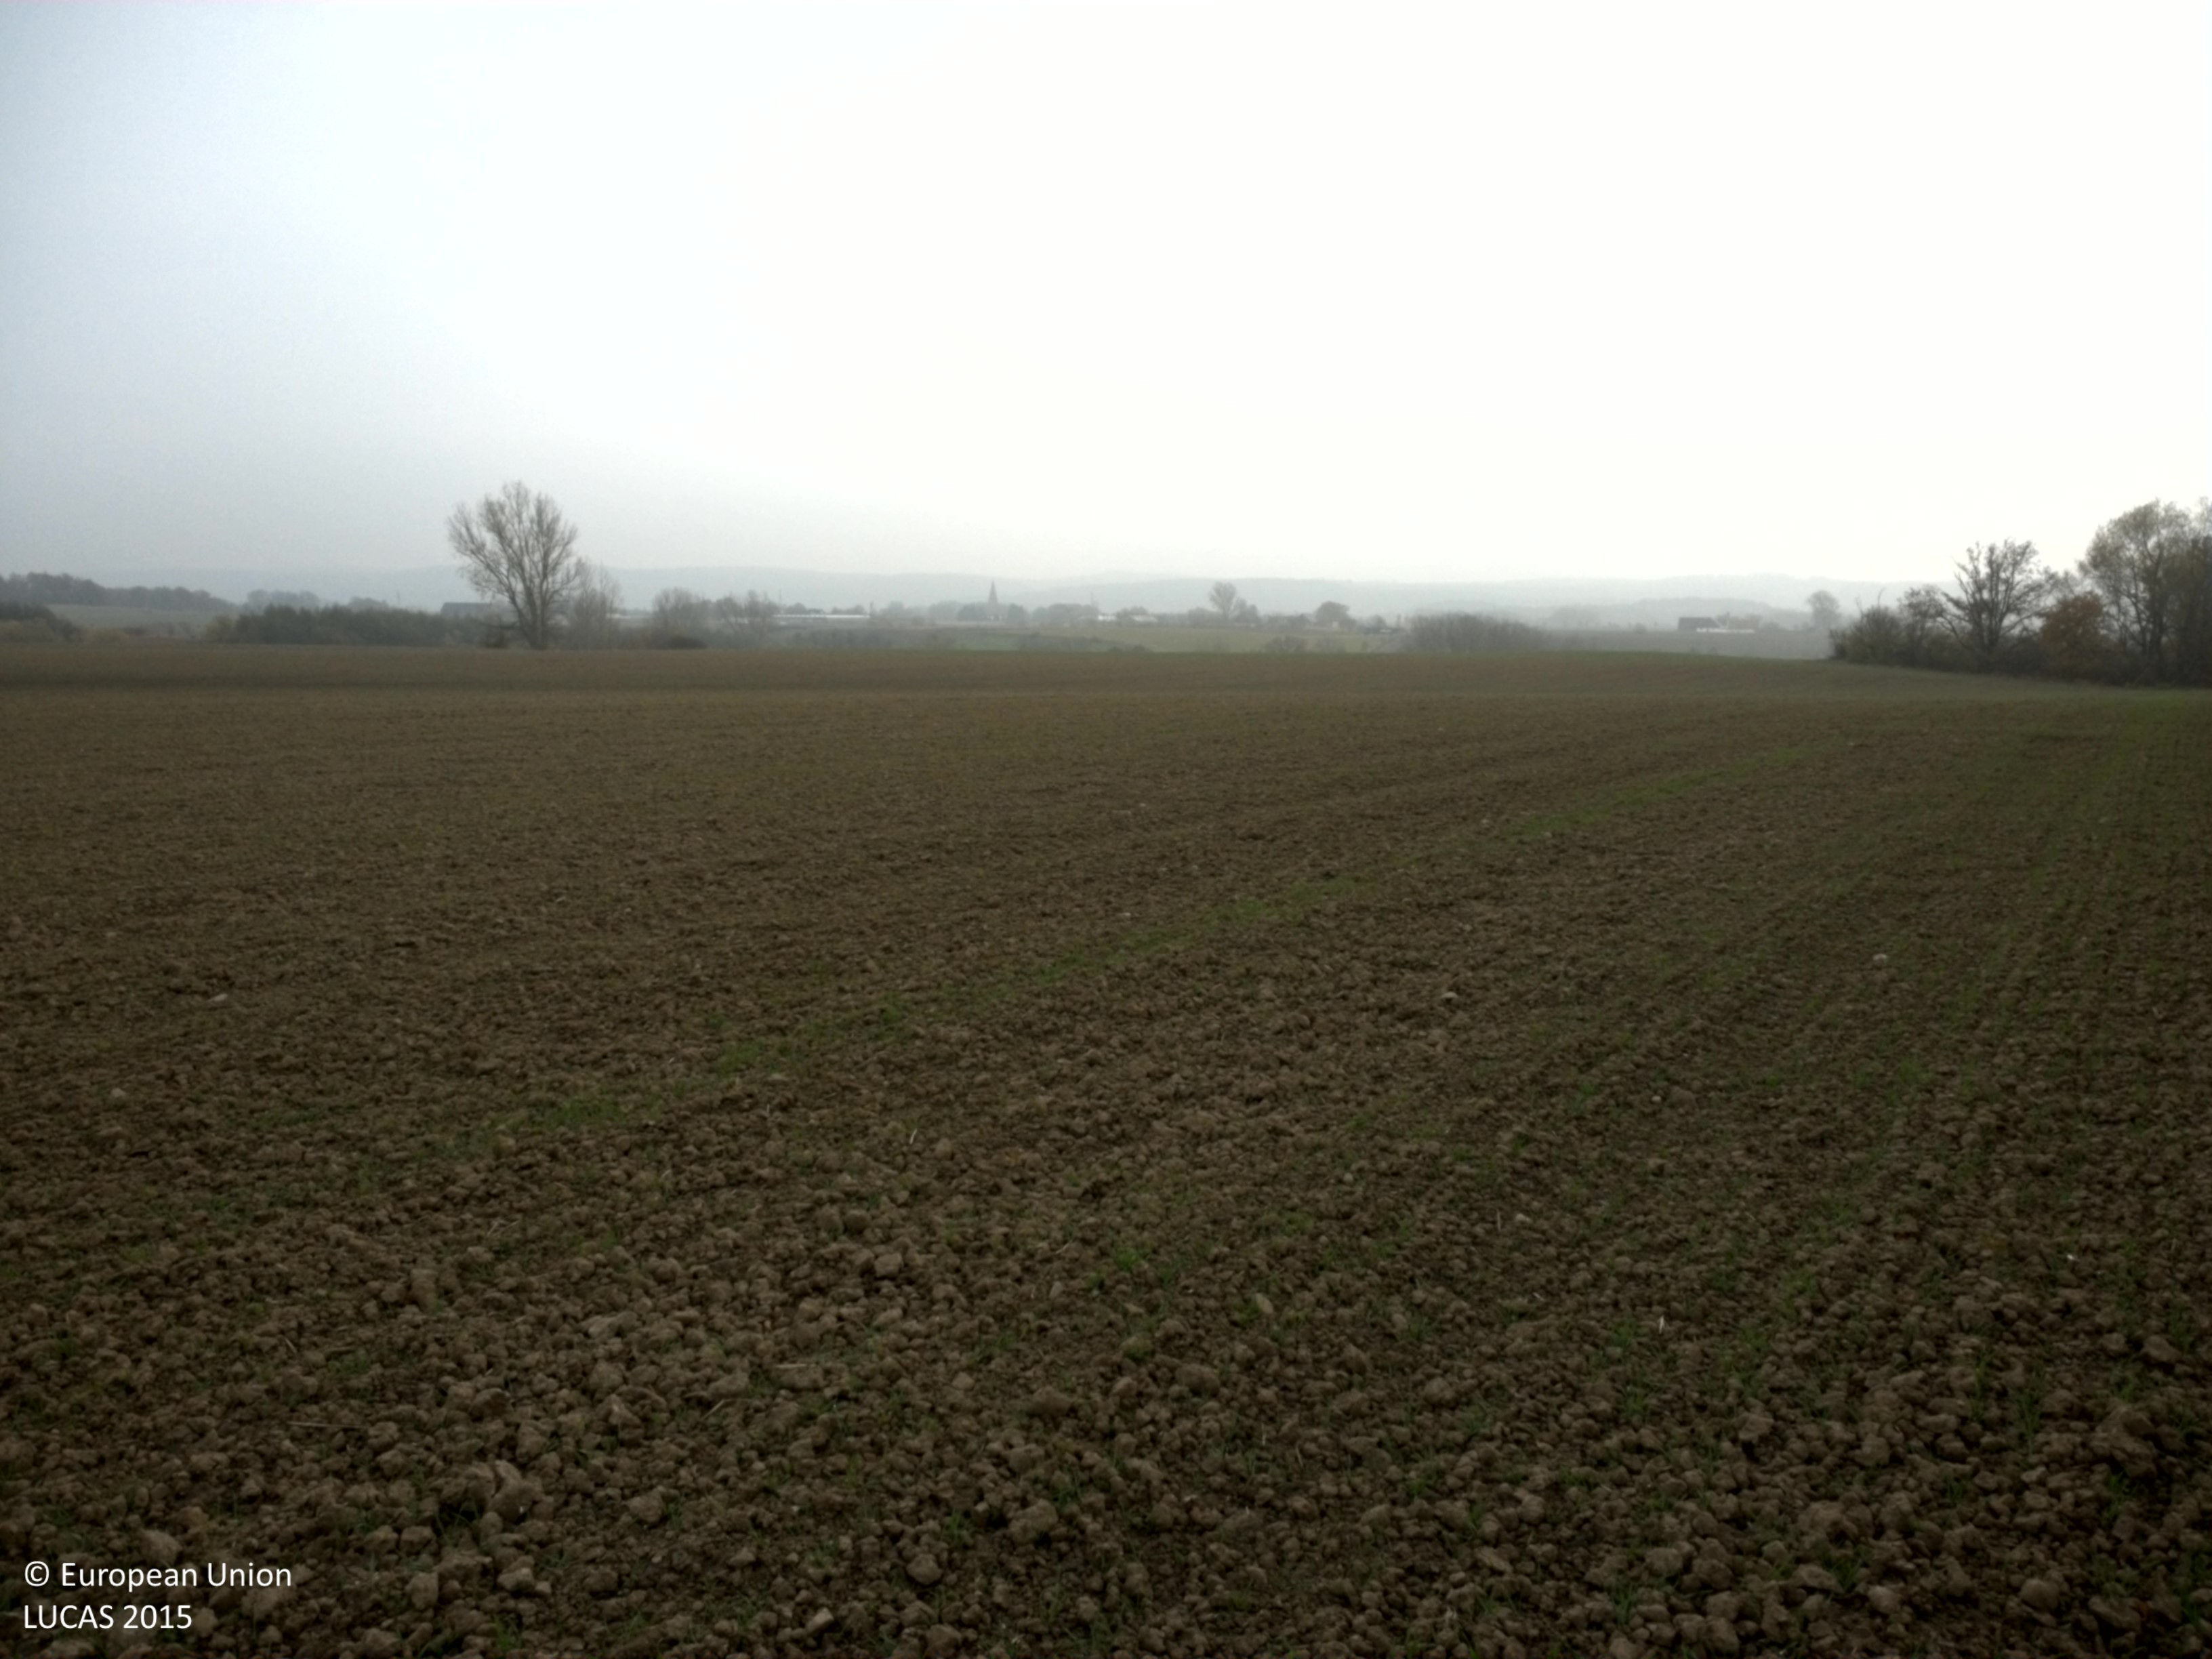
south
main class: Cropland
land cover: Common wheat
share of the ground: < 10 %
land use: Agriculture (excluding fallow land and kitchen gardens)
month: November
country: SE
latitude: 56.1323
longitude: 13.1028
